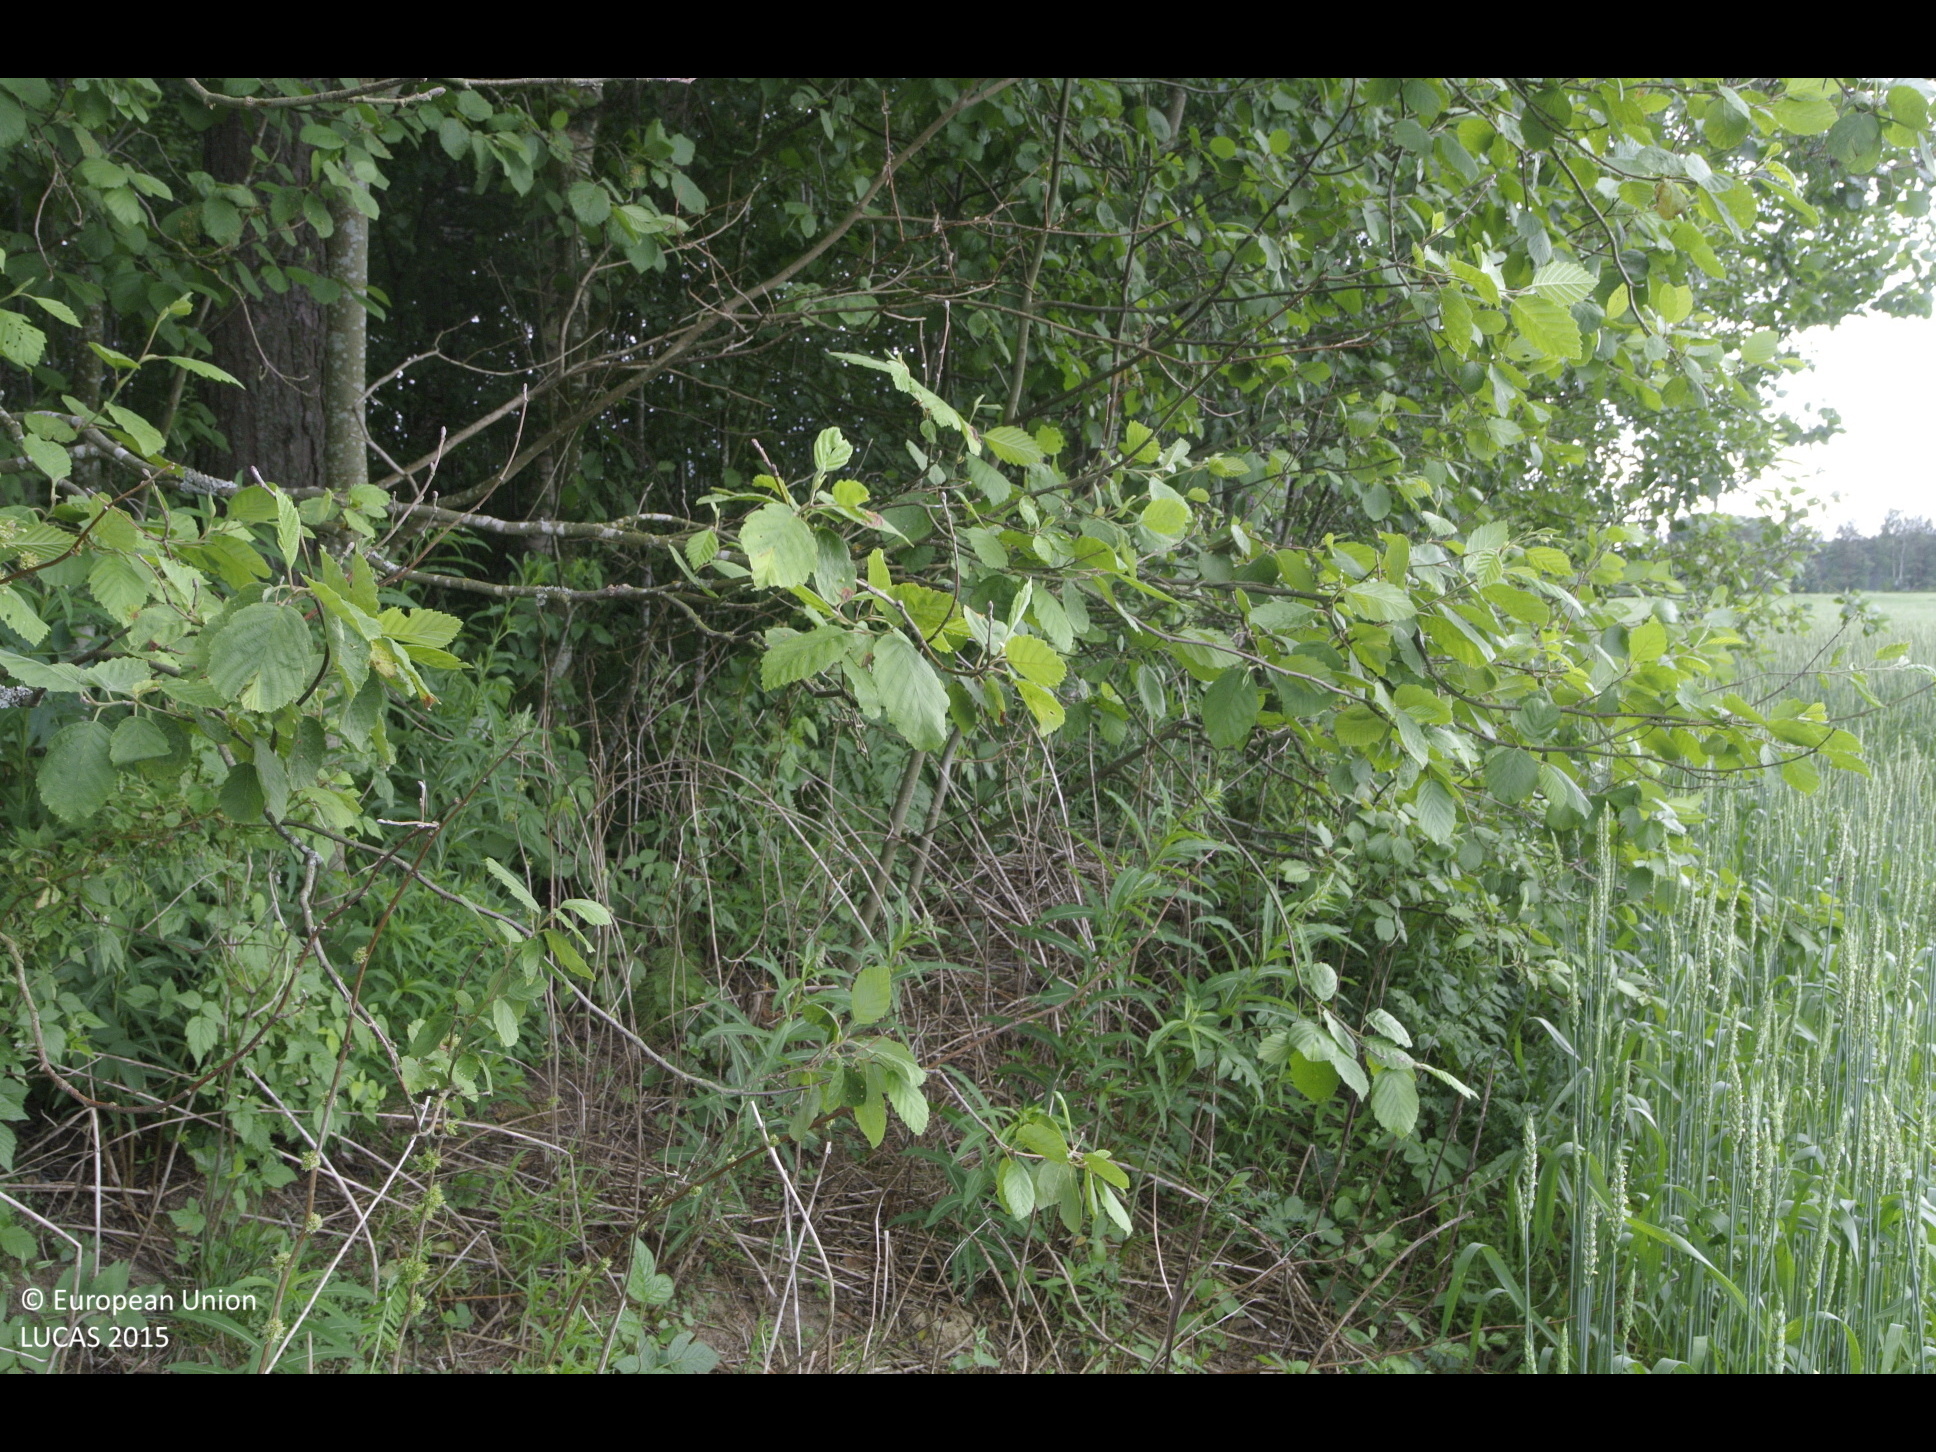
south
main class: Cropland
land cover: Common wheat
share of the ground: > 75 %
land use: Agriculture (excluding fallow land and kitchen gardens)
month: July
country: FI
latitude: 61.3170
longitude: 25.7237
